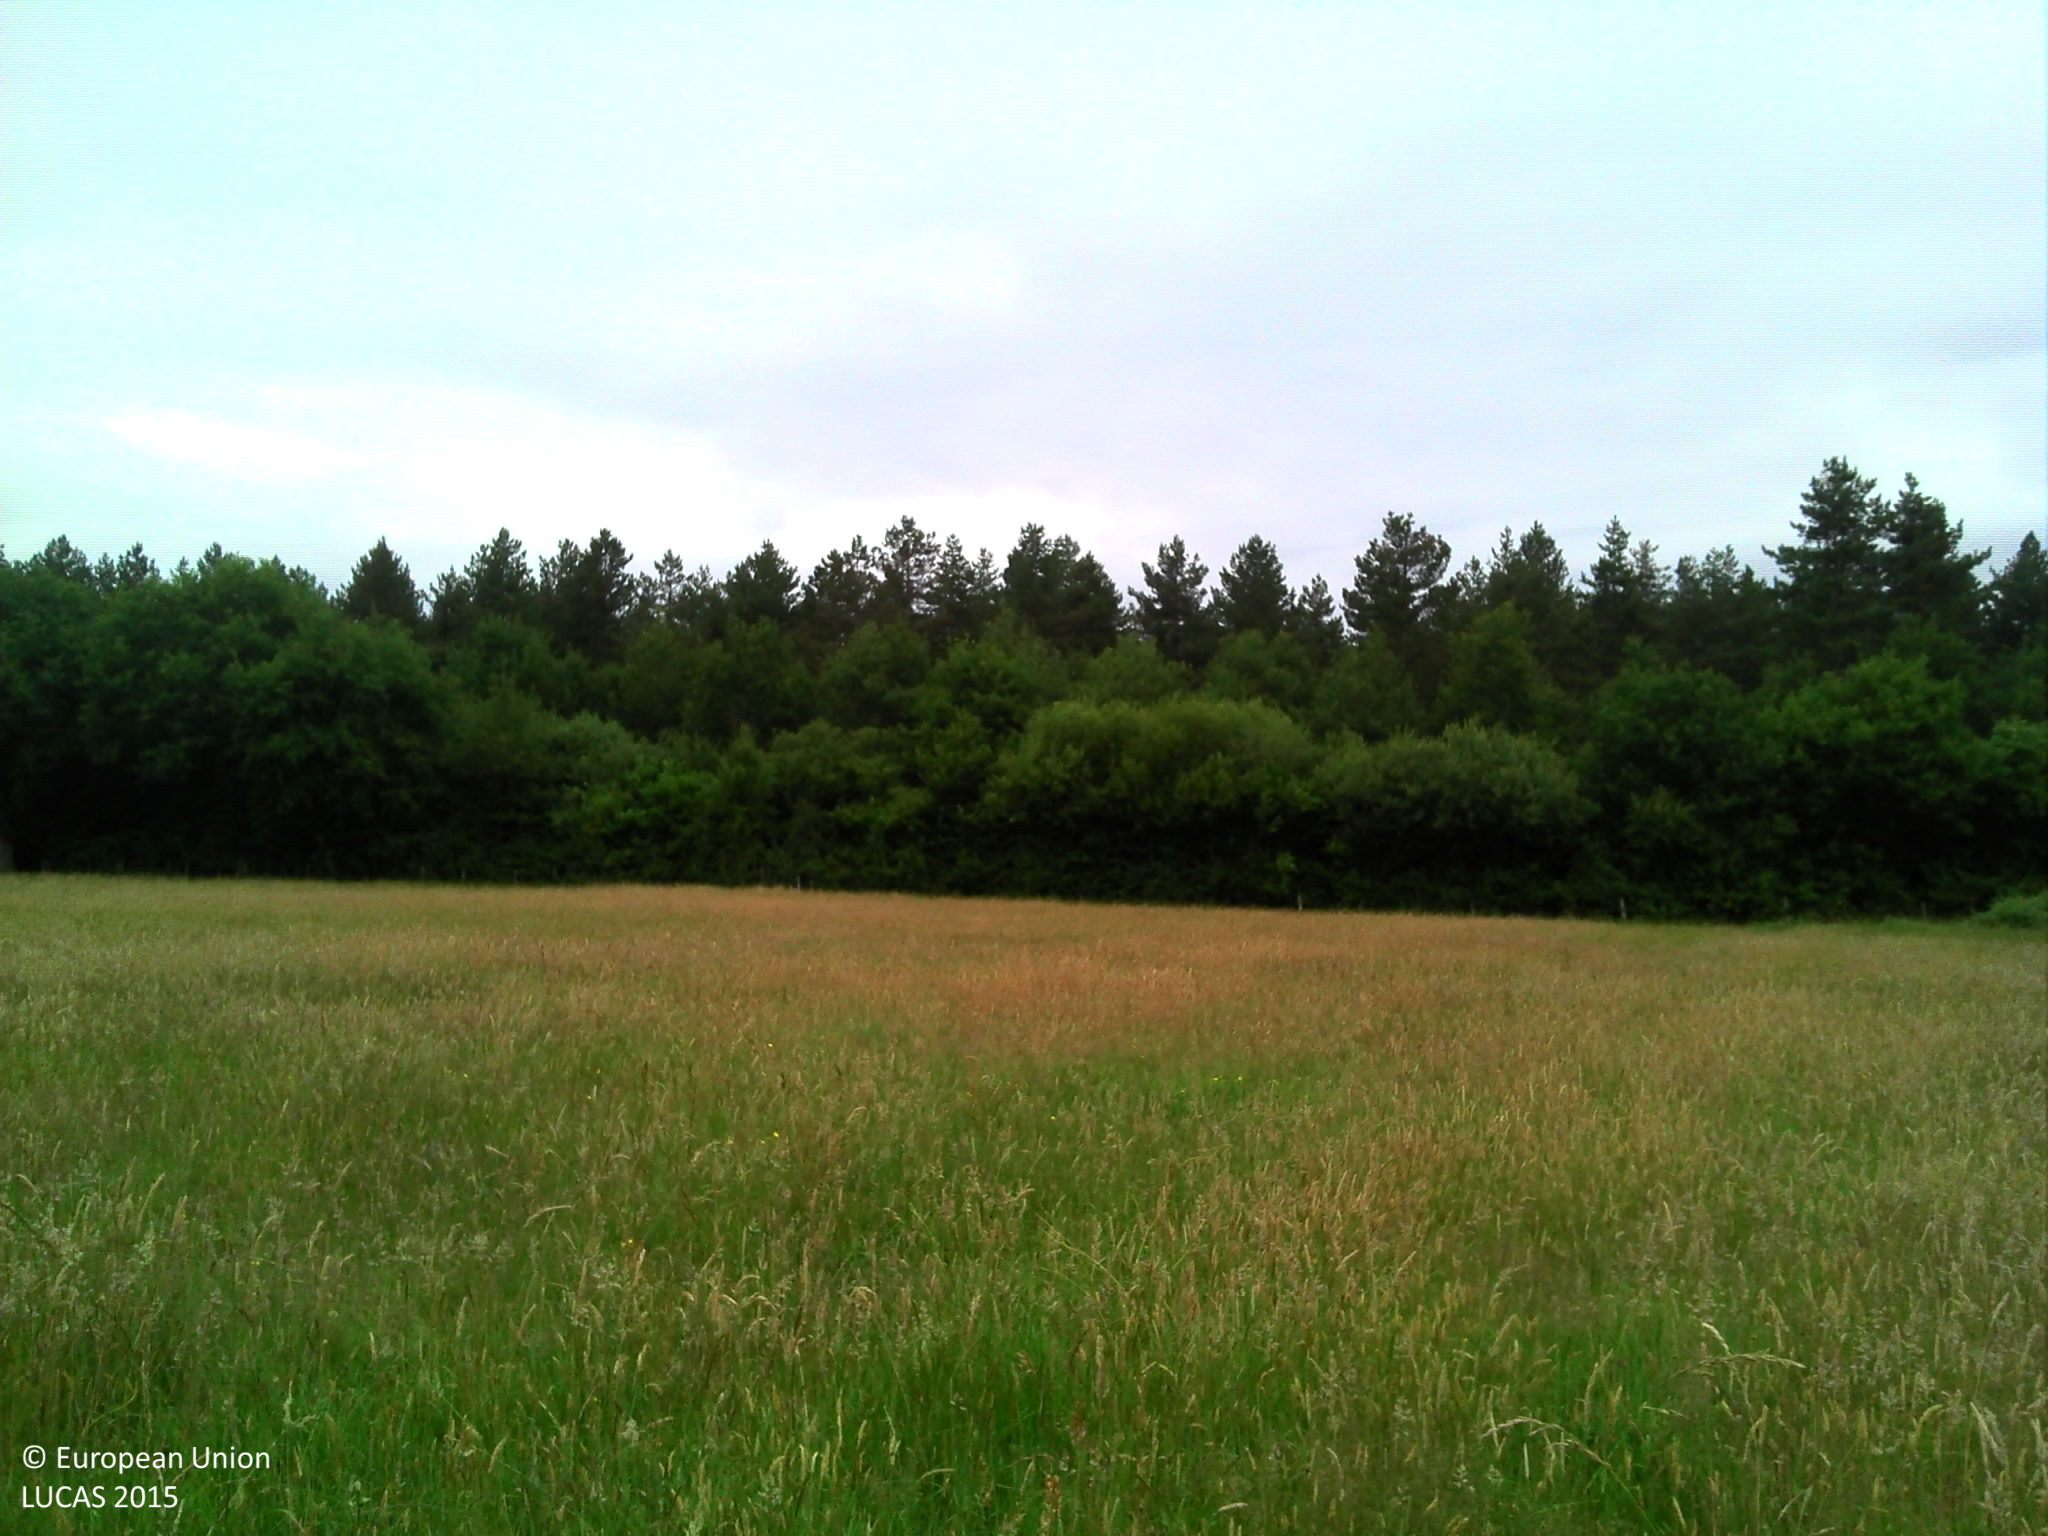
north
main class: Grassland
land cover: Grassland without tree/shrub cover
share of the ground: > 75 %
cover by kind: herbaceous plants 100 %
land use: Agriculture (excluding fallow land and kitchen gardens)
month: June
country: FR
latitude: 47.6460
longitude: 0.0565
